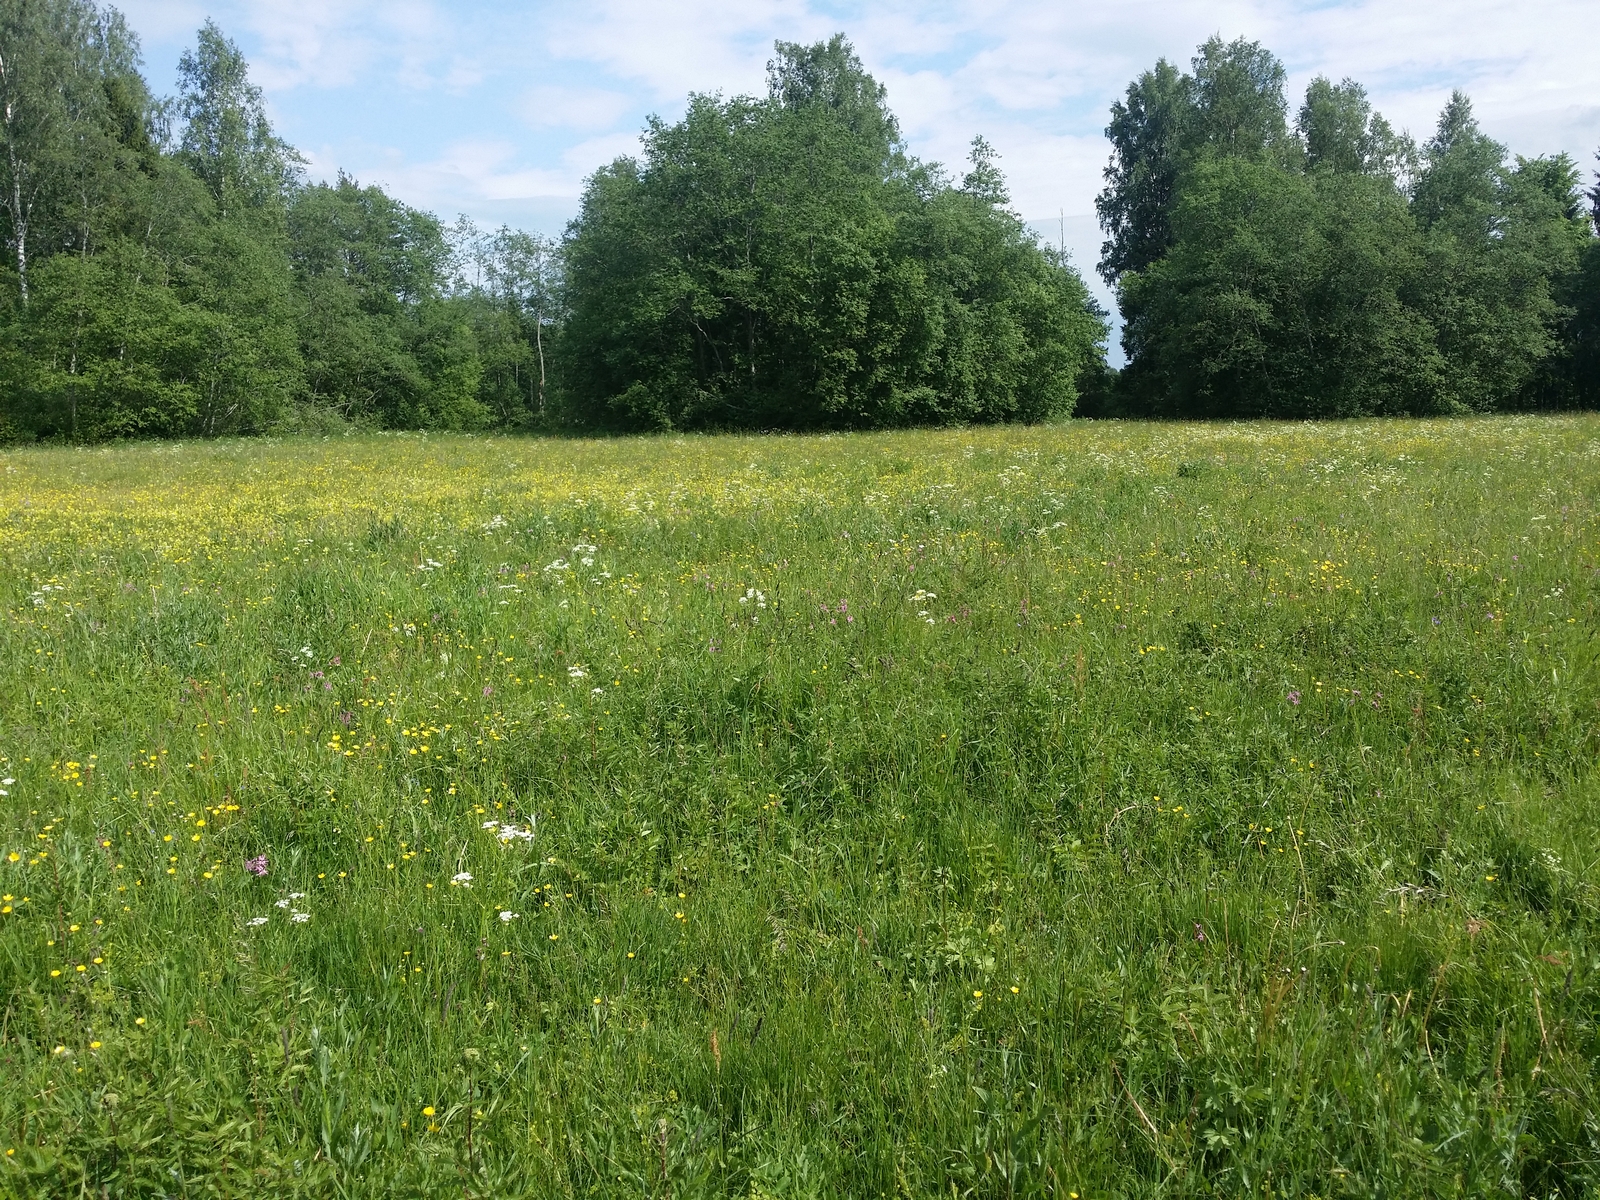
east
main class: Grassland
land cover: Spontaneously vegetated surfaces
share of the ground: > 75 %
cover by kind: herbaceous plants 100 %
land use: Fallow land
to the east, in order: Spontaneously vegetated surfaces; Broadleaved woodland; Spontaneously vegetated surfaces; Spruce dominated coniferous woodland; Broadleaved woodland; Inland fresh running water; Broadleaved woodland
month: June
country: LV
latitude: 57.3740
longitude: 26.4902
